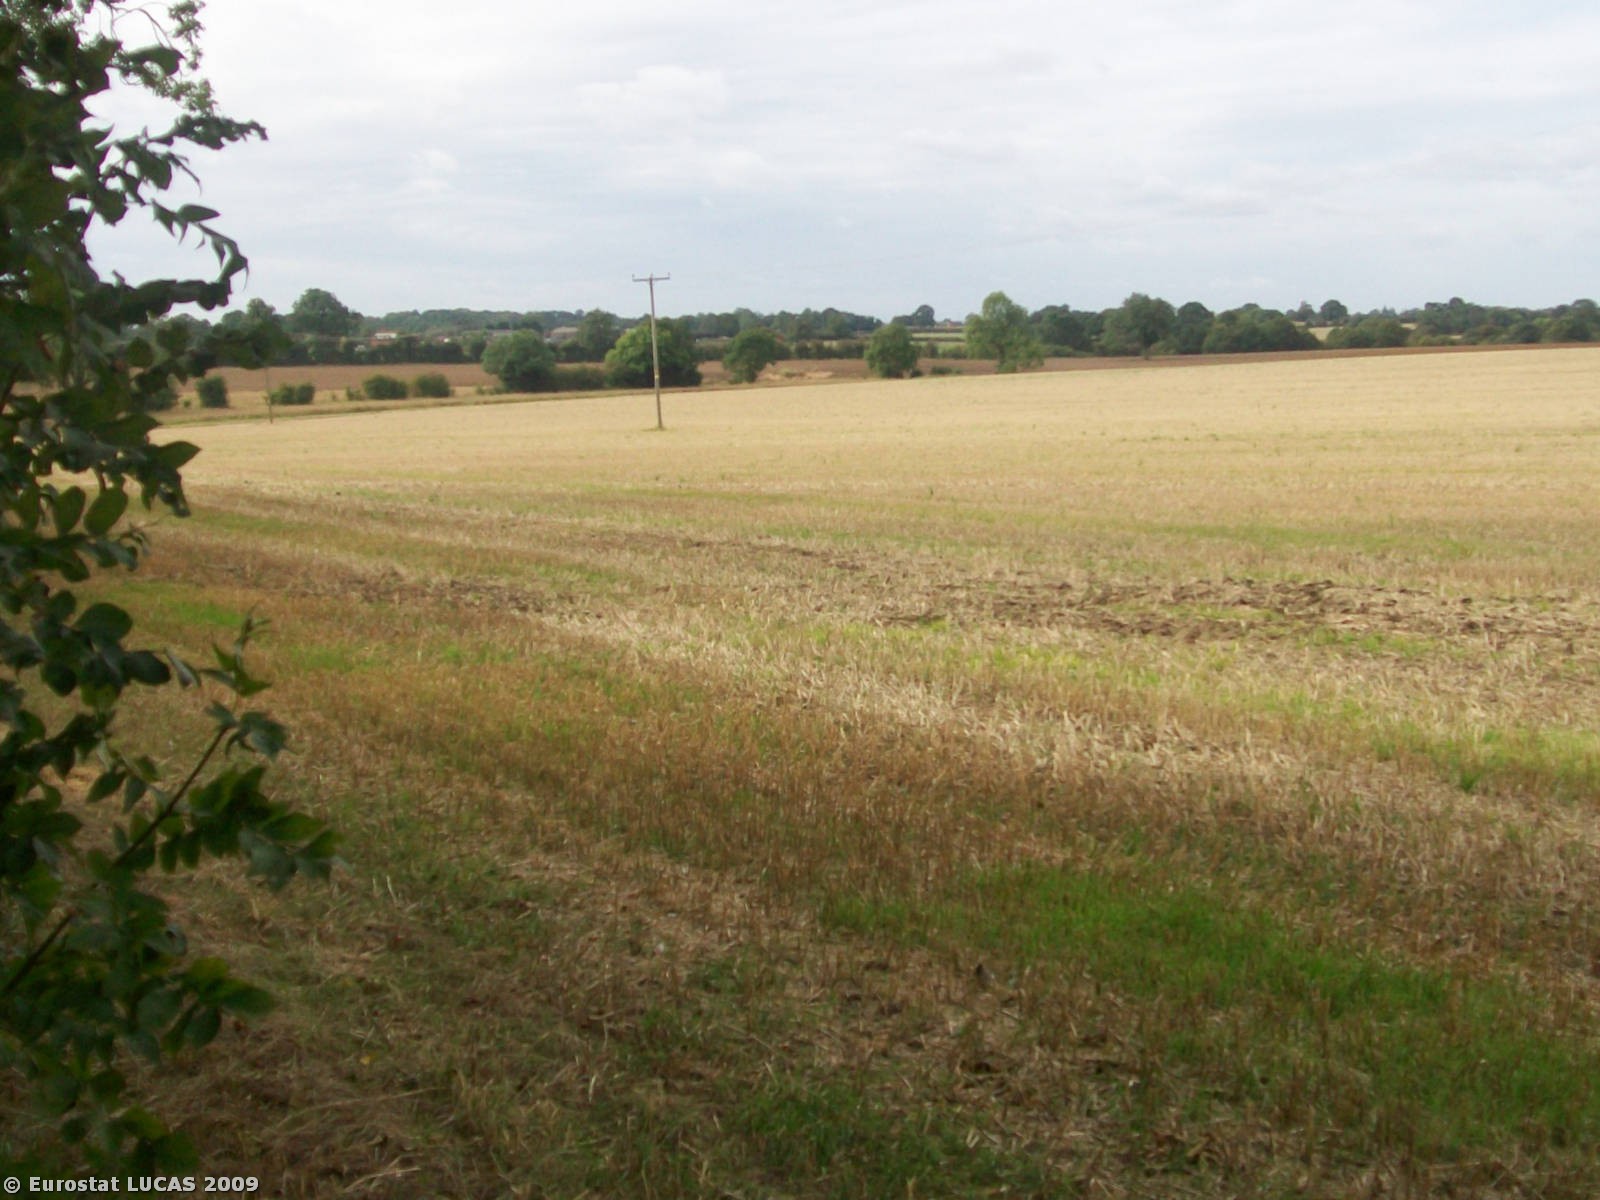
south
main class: Bare land
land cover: Bare land
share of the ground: < 10 %
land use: Agriculture (excluding fallow land and kitchen gardens)
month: September
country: GB
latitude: 52.4827
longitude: -1.3727
